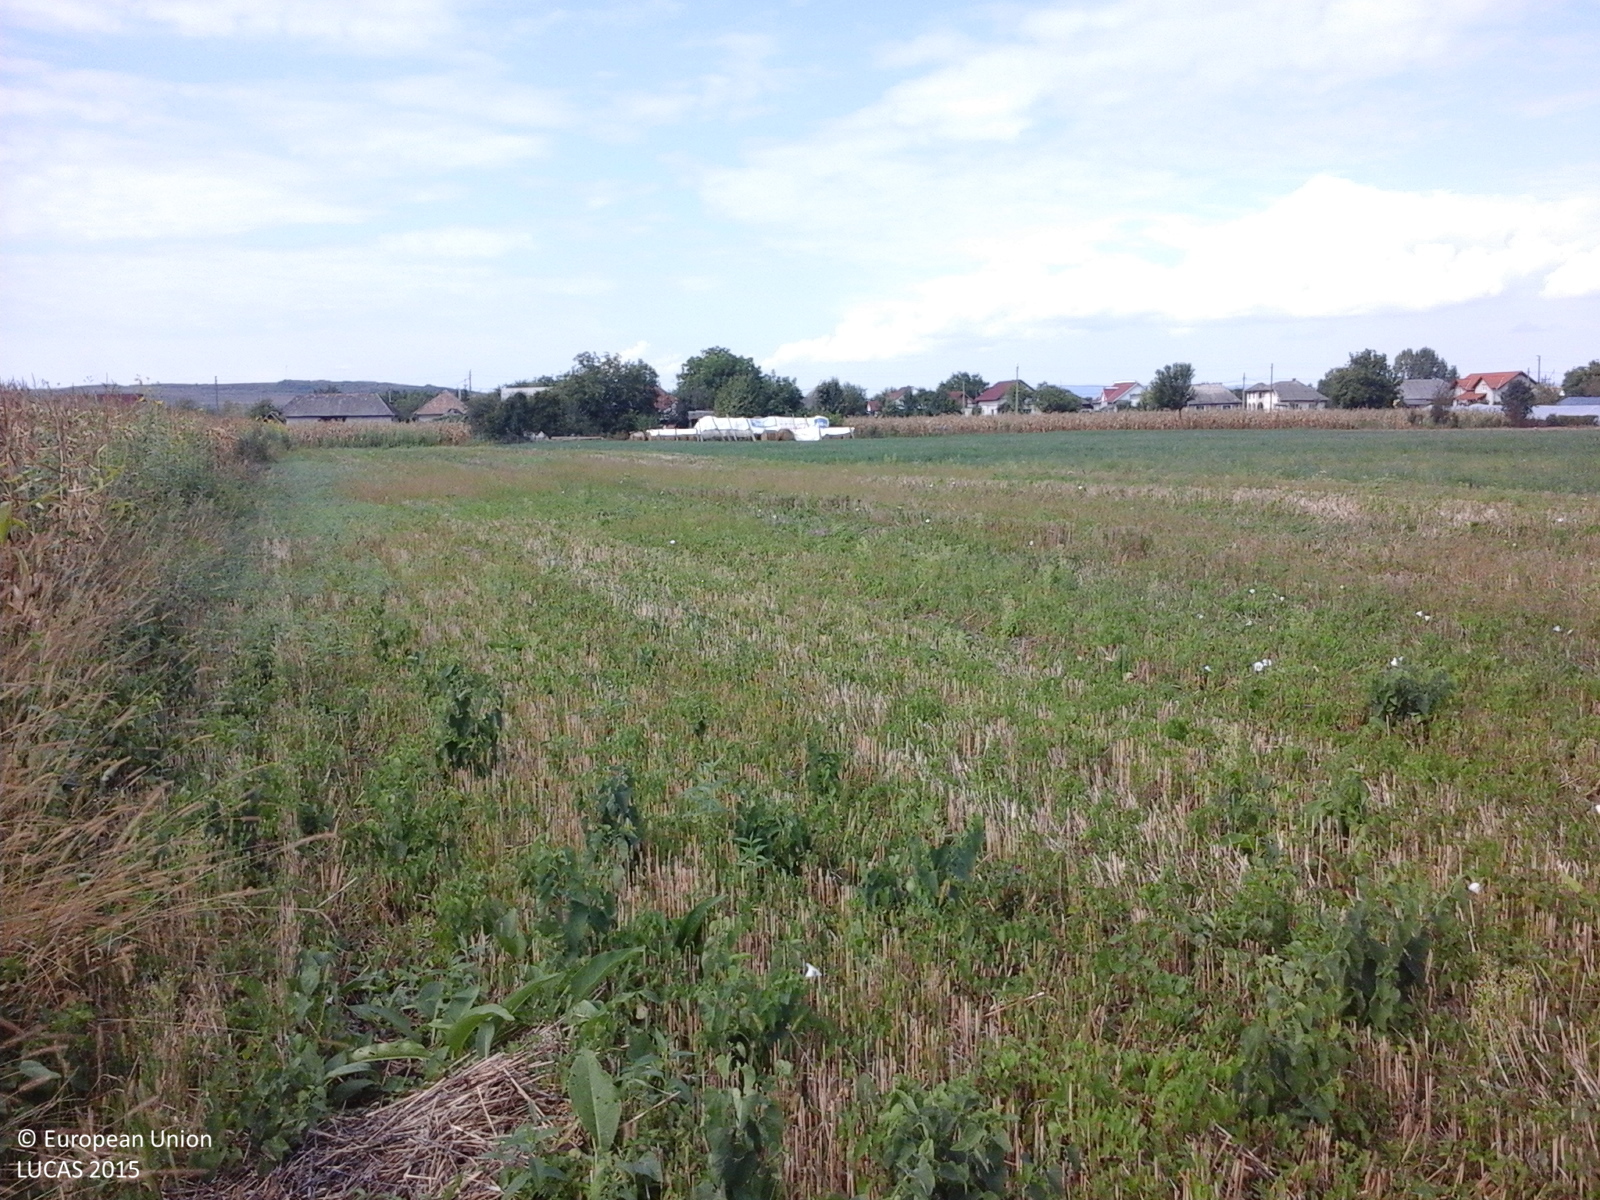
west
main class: Cropland
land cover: Maize
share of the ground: > 75 %
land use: Agriculture (excluding fallow land and kitchen gardens)
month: September
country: RO
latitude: 47.5036
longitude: 23.3067
